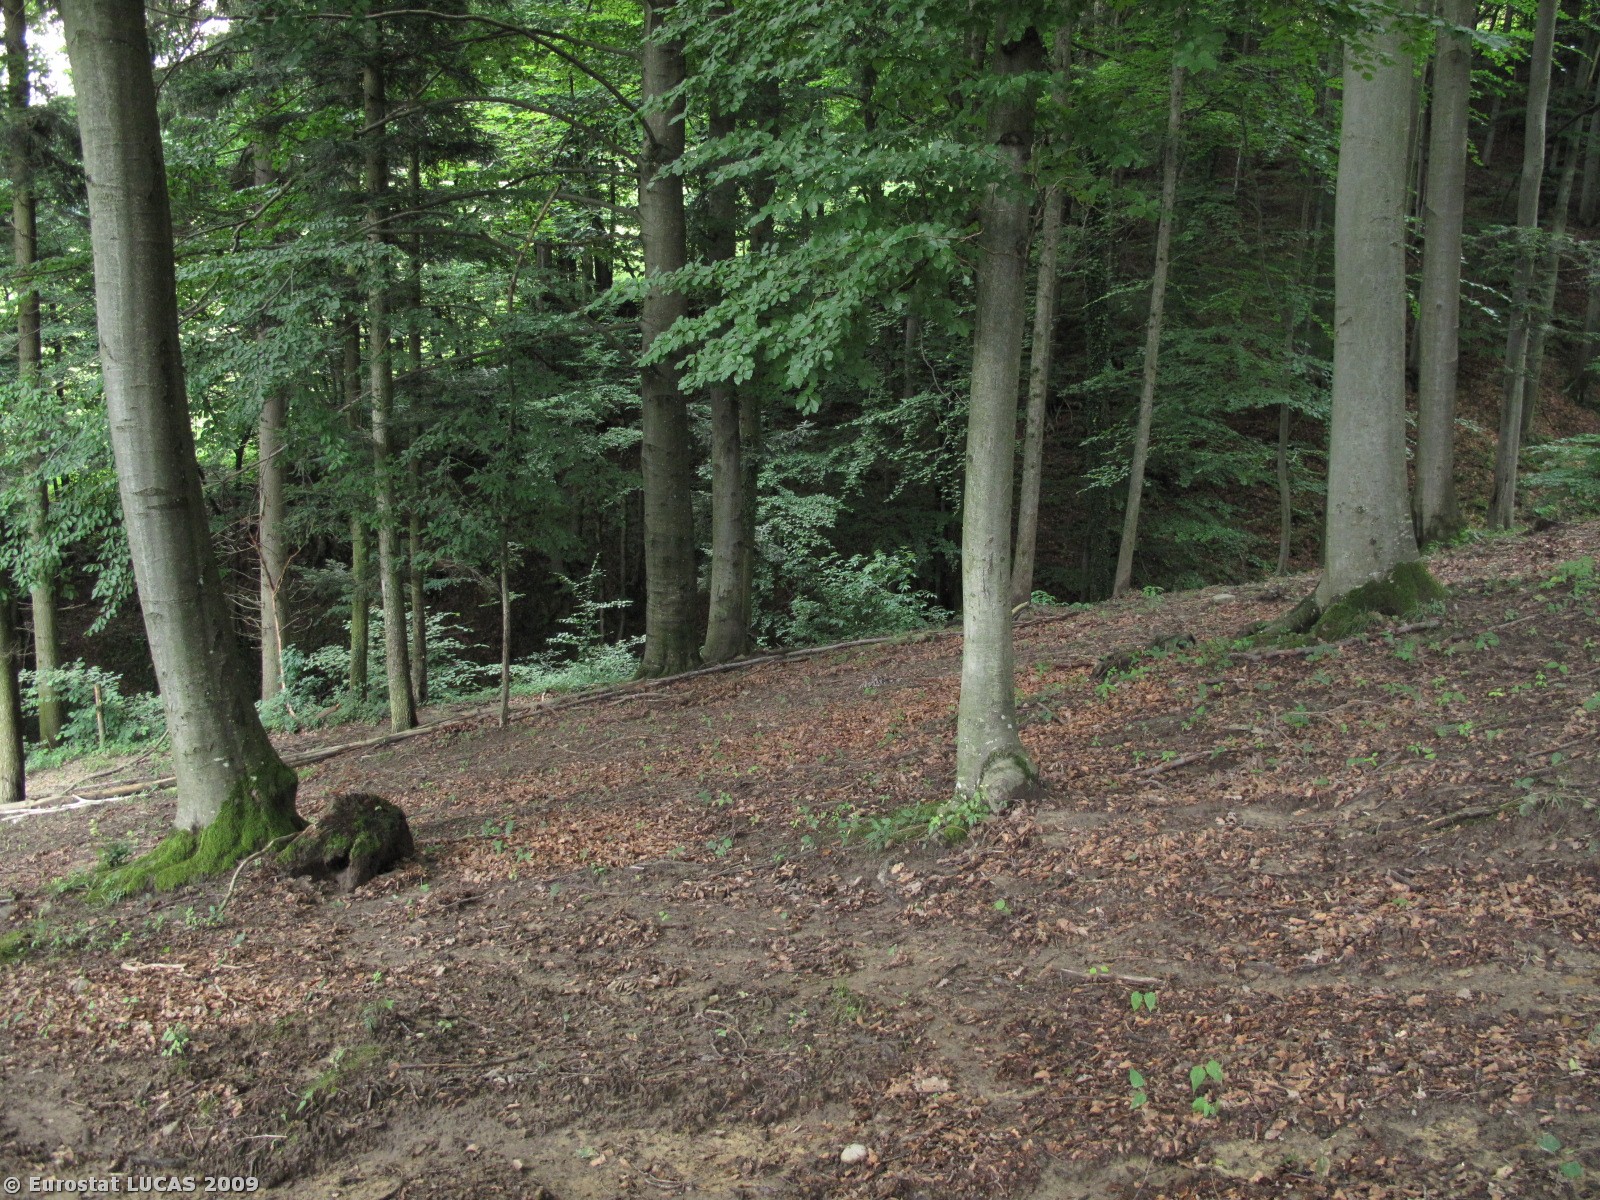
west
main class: Woodland
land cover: Broadleaved woodland
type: mesophytic deciduous forest
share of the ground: > 75 %
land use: Forestry
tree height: > 5 m
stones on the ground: > 50 %
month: July
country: AT
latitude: 48.1116
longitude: 15.7111
